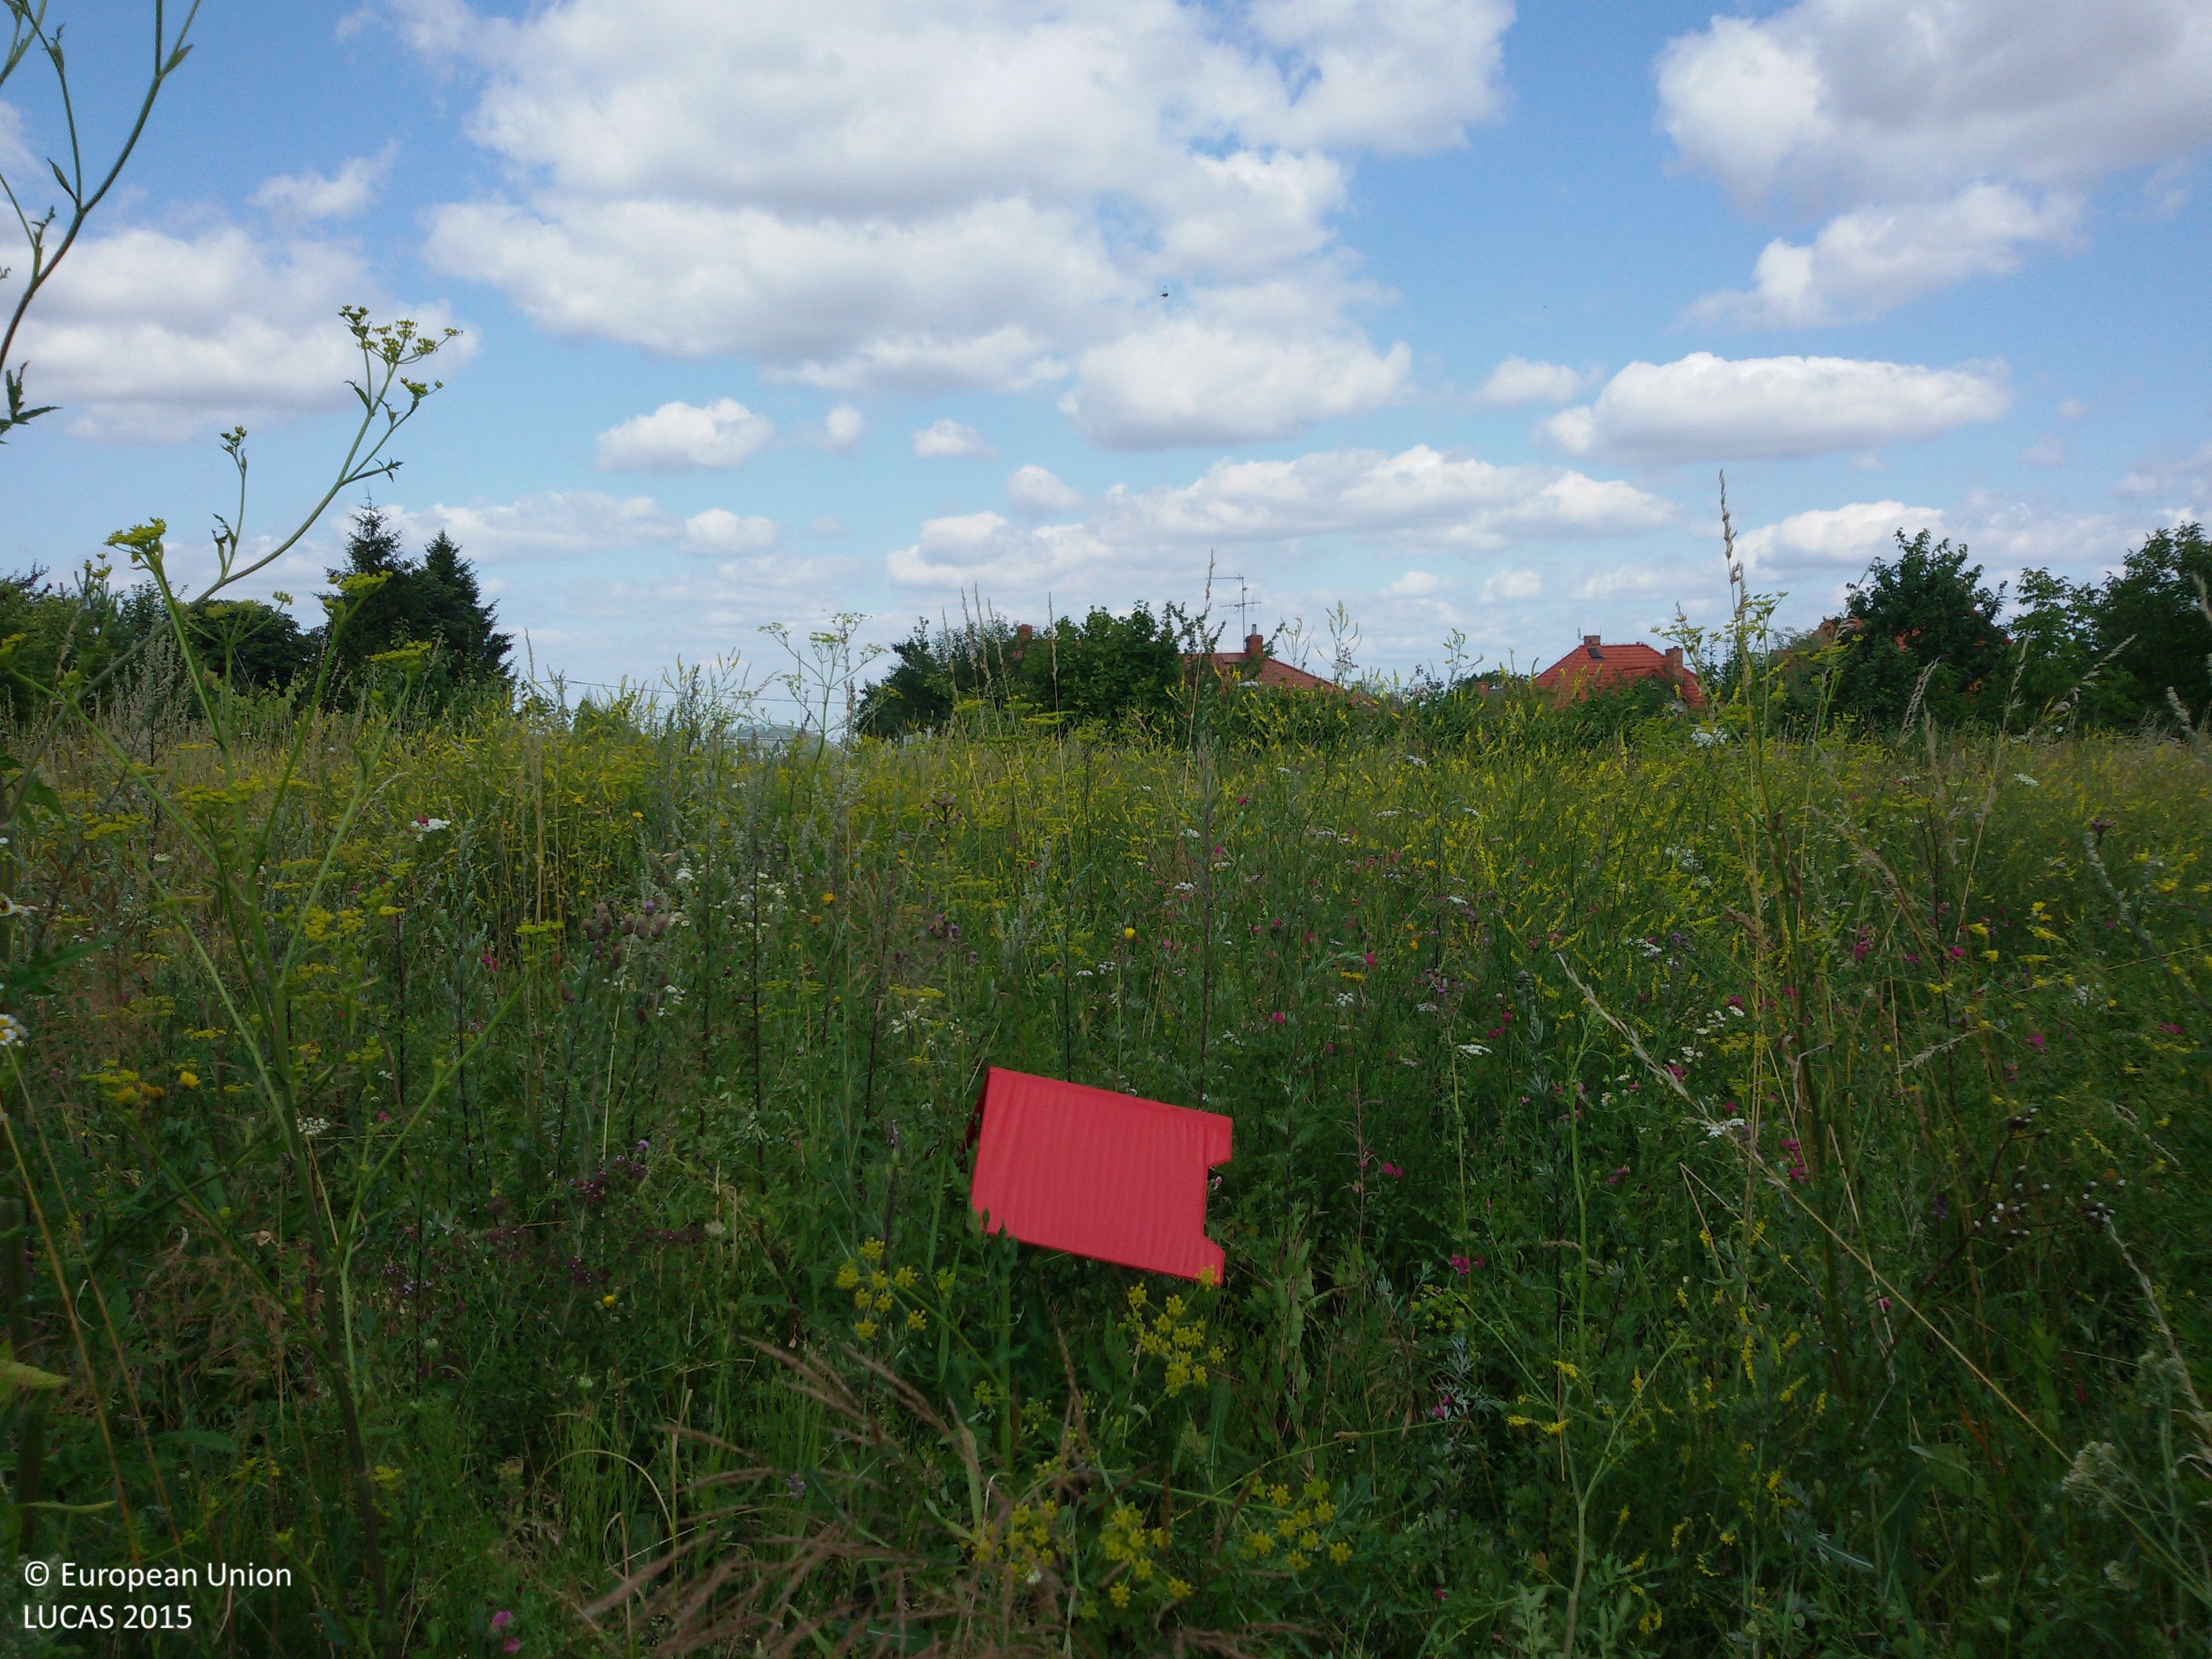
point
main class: Woodland
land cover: Other mixed woodland
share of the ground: 10 - 25 %
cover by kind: herbaceous plants 85 %, coniferous forest trees 5 %, broadleaved forest trees 5 %, shrubs 5 %
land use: Abandoned areas
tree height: < 5 m
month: July
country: PL
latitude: 51.1580
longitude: 23.3941
